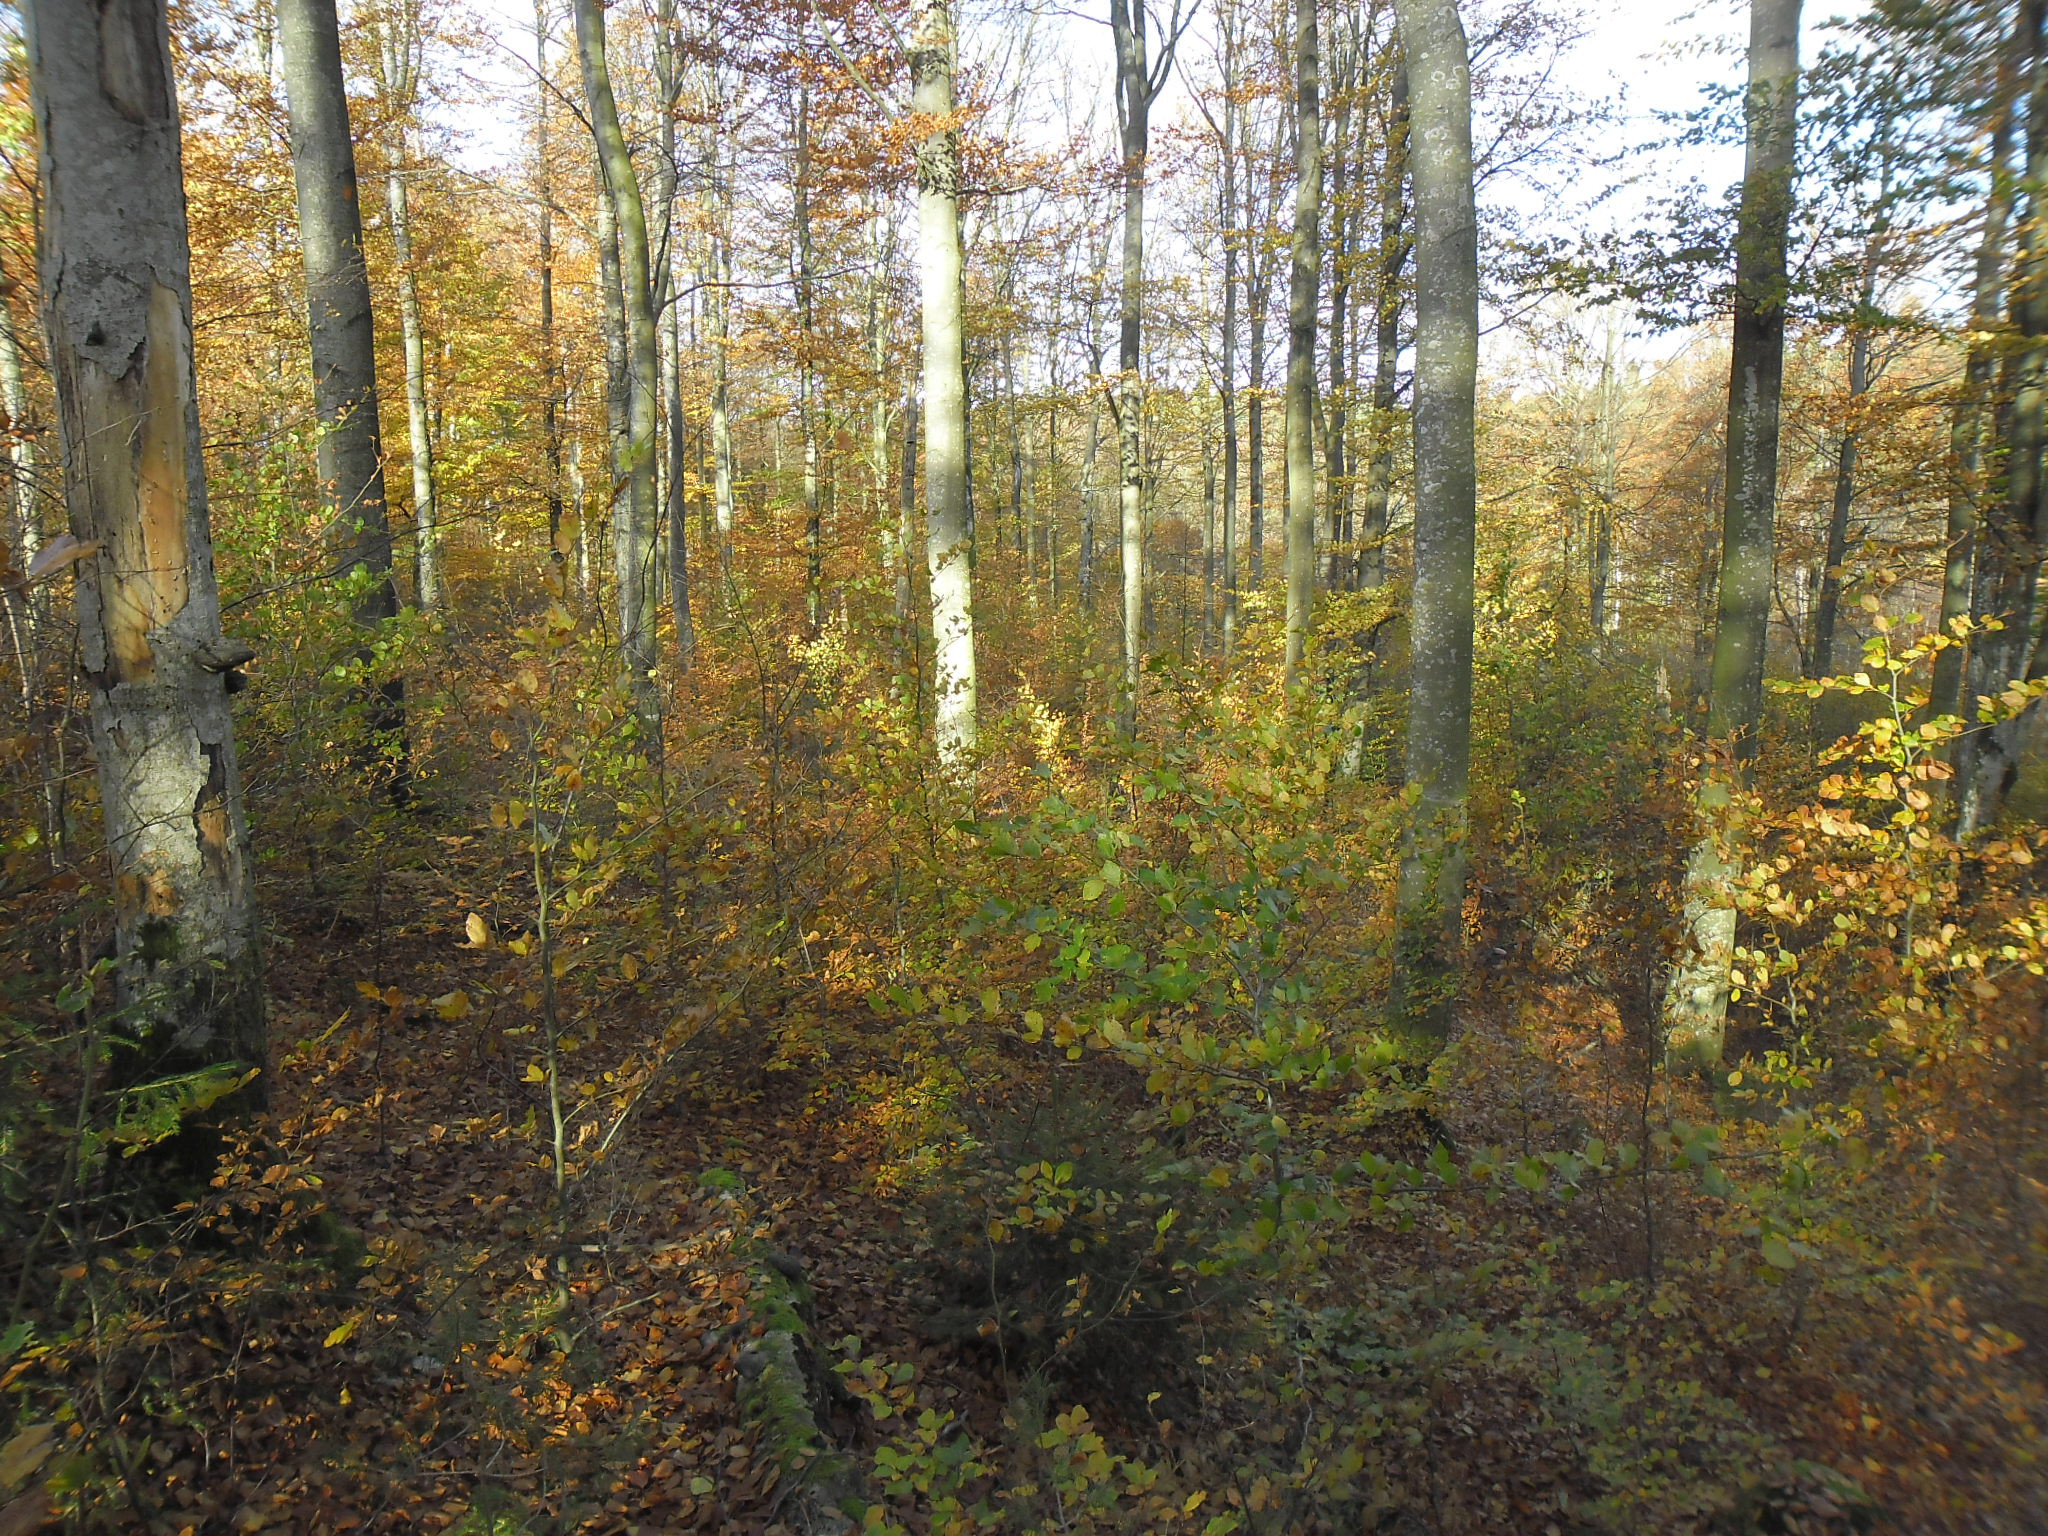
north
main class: Woodland
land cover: Broadleaved woodland
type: beech forest
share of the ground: > 75 %
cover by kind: broadleaved forest trees 80 %, herbaceous plants 20 %
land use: Forestry
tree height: > 5 m
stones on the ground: > 50 %
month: October
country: SE
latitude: 56.3665
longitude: 13.0892
